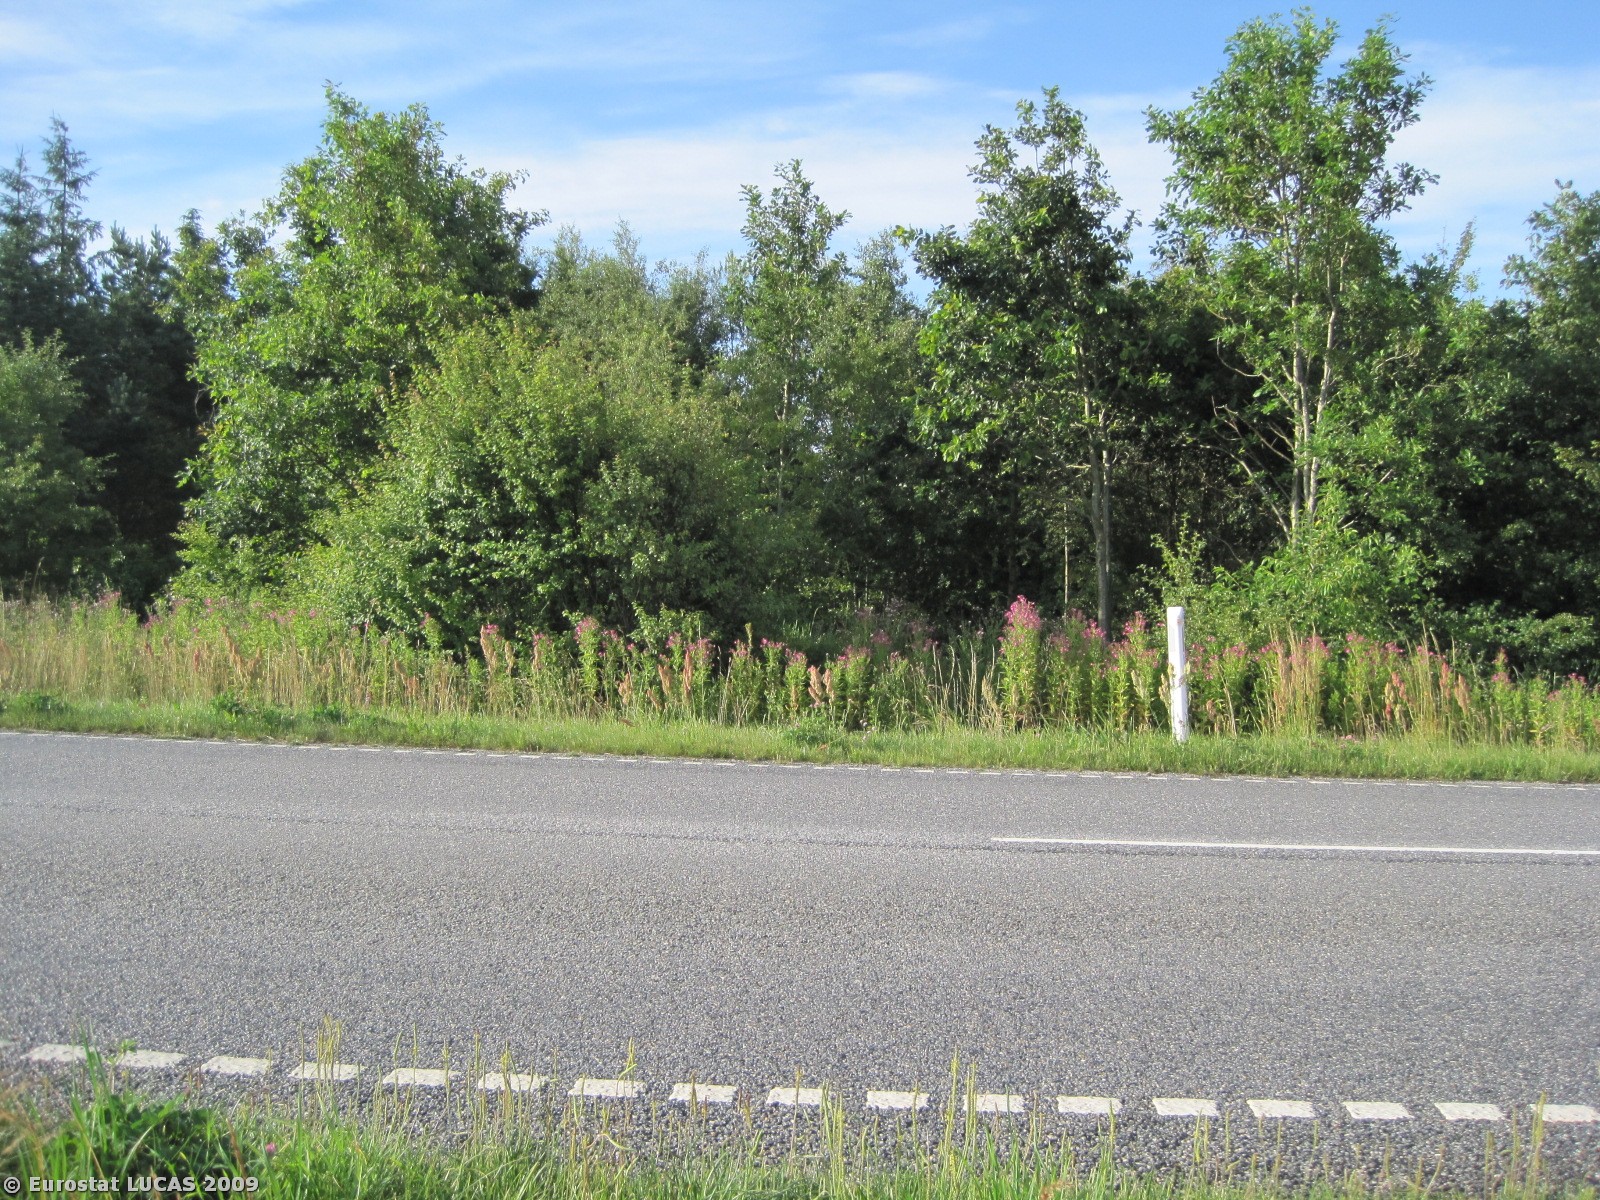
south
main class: Cropland
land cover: Common wheat
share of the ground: > 75 %
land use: Agriculture (excluding fallow land and kitchen gardens)
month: July
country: DK
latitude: 57.0106
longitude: 8.9641
